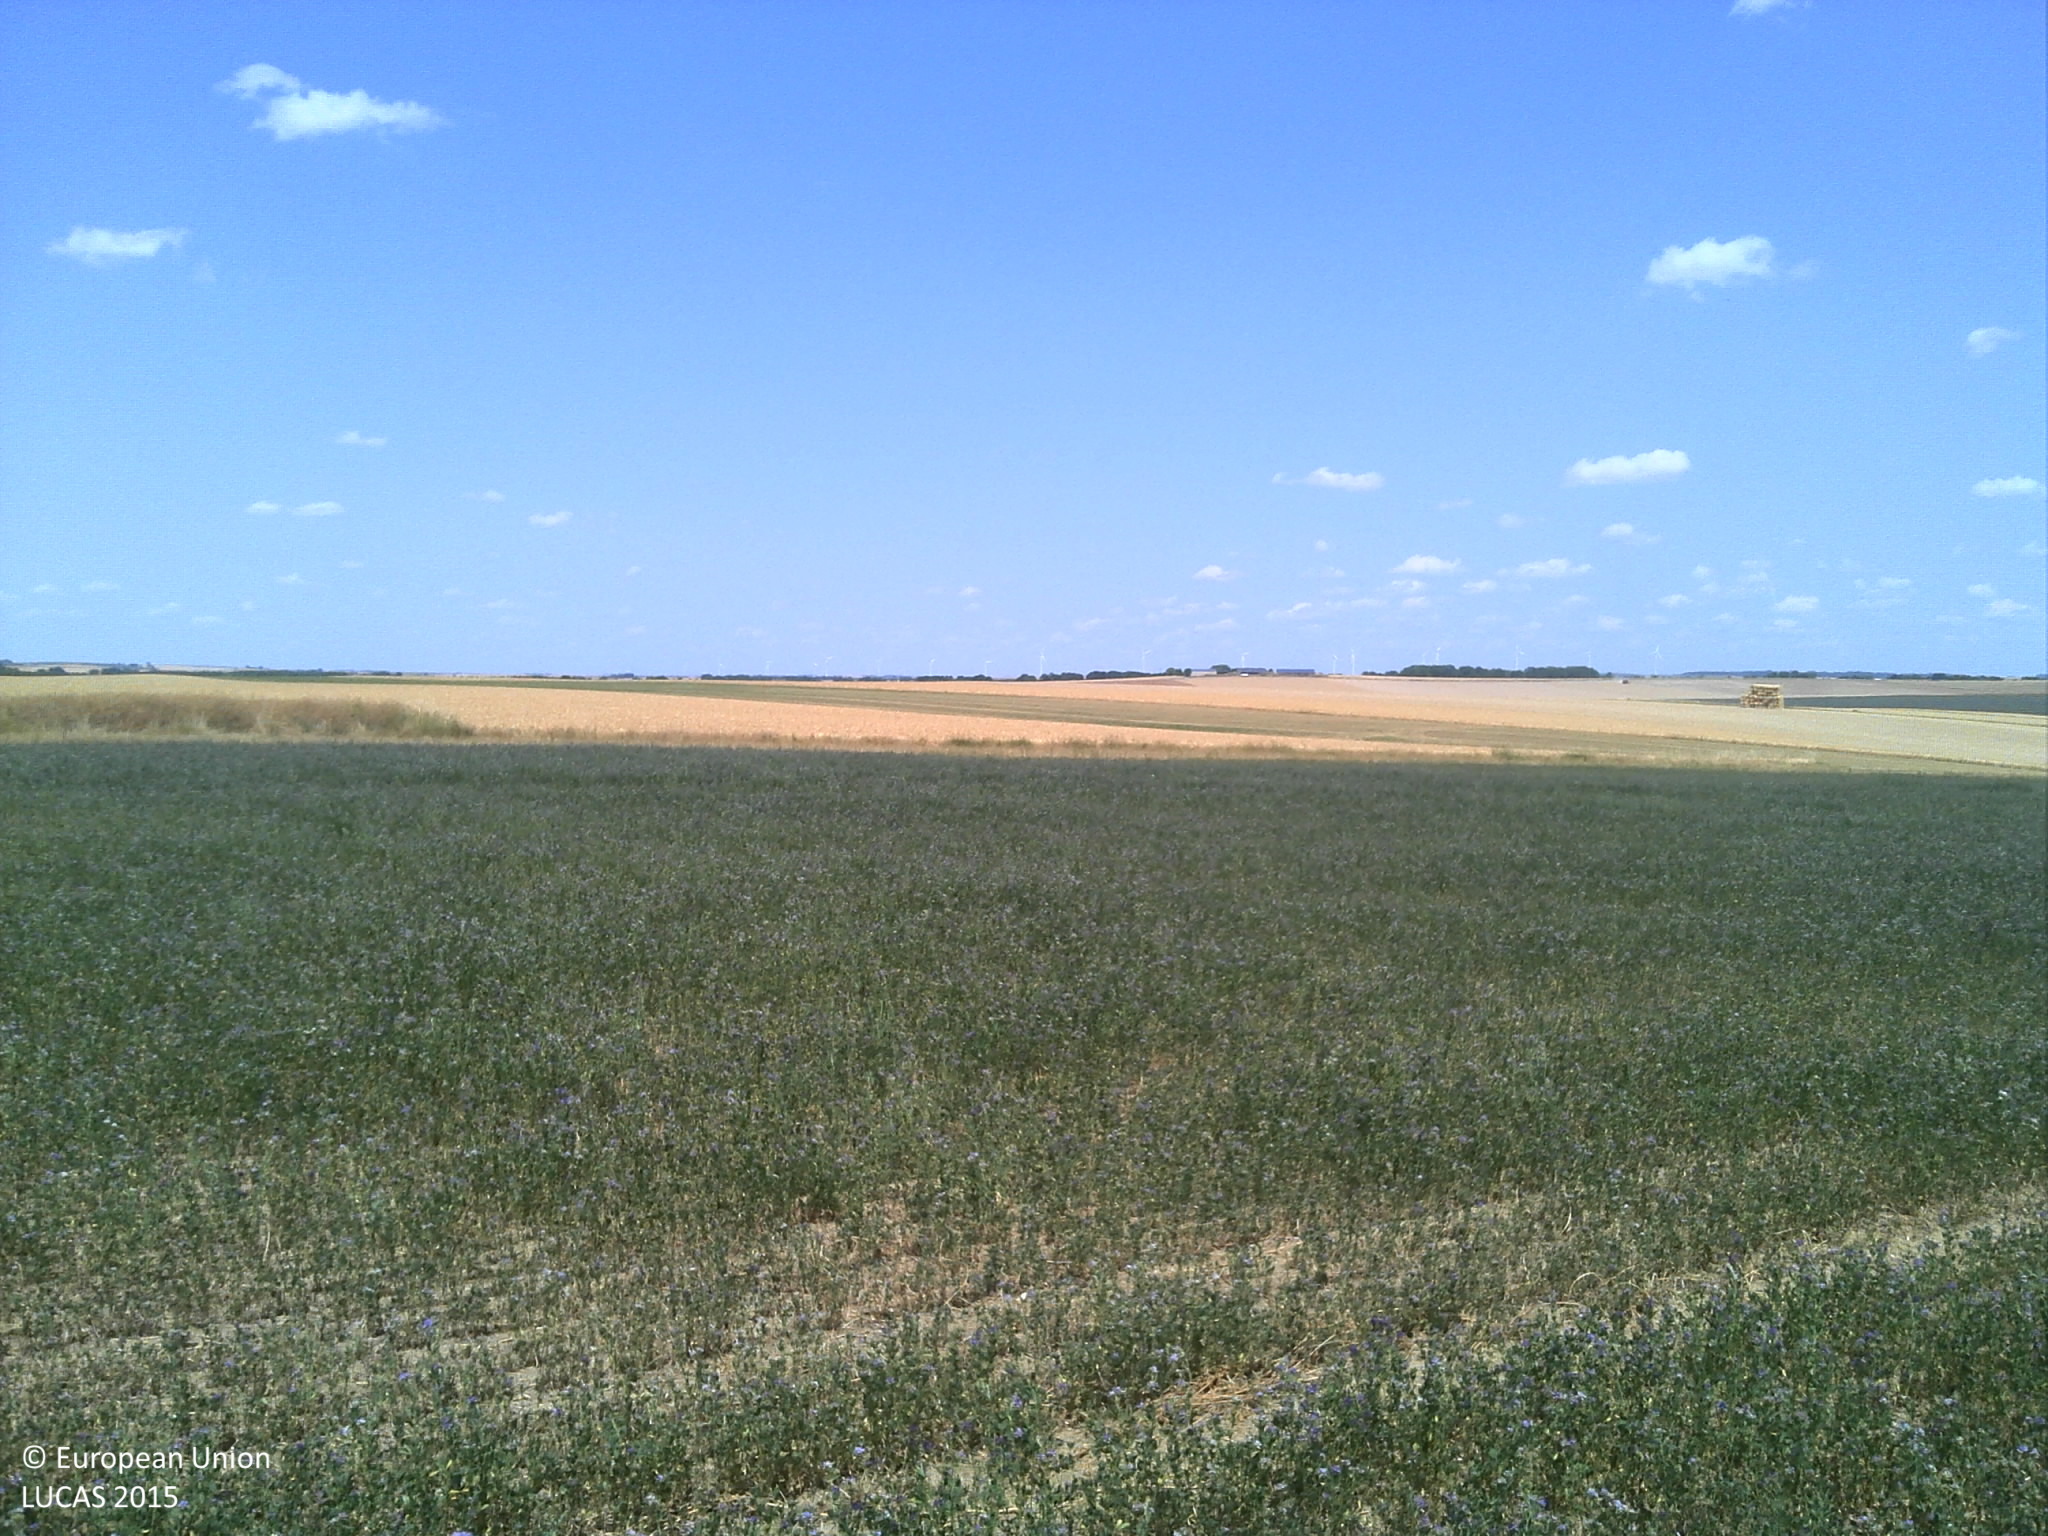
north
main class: Cropland
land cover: Lucerne
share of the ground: > 75 %
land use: Agriculture (excluding fallow land and kitchen gardens)
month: July
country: FR
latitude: 49.4561
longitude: 4.1320
